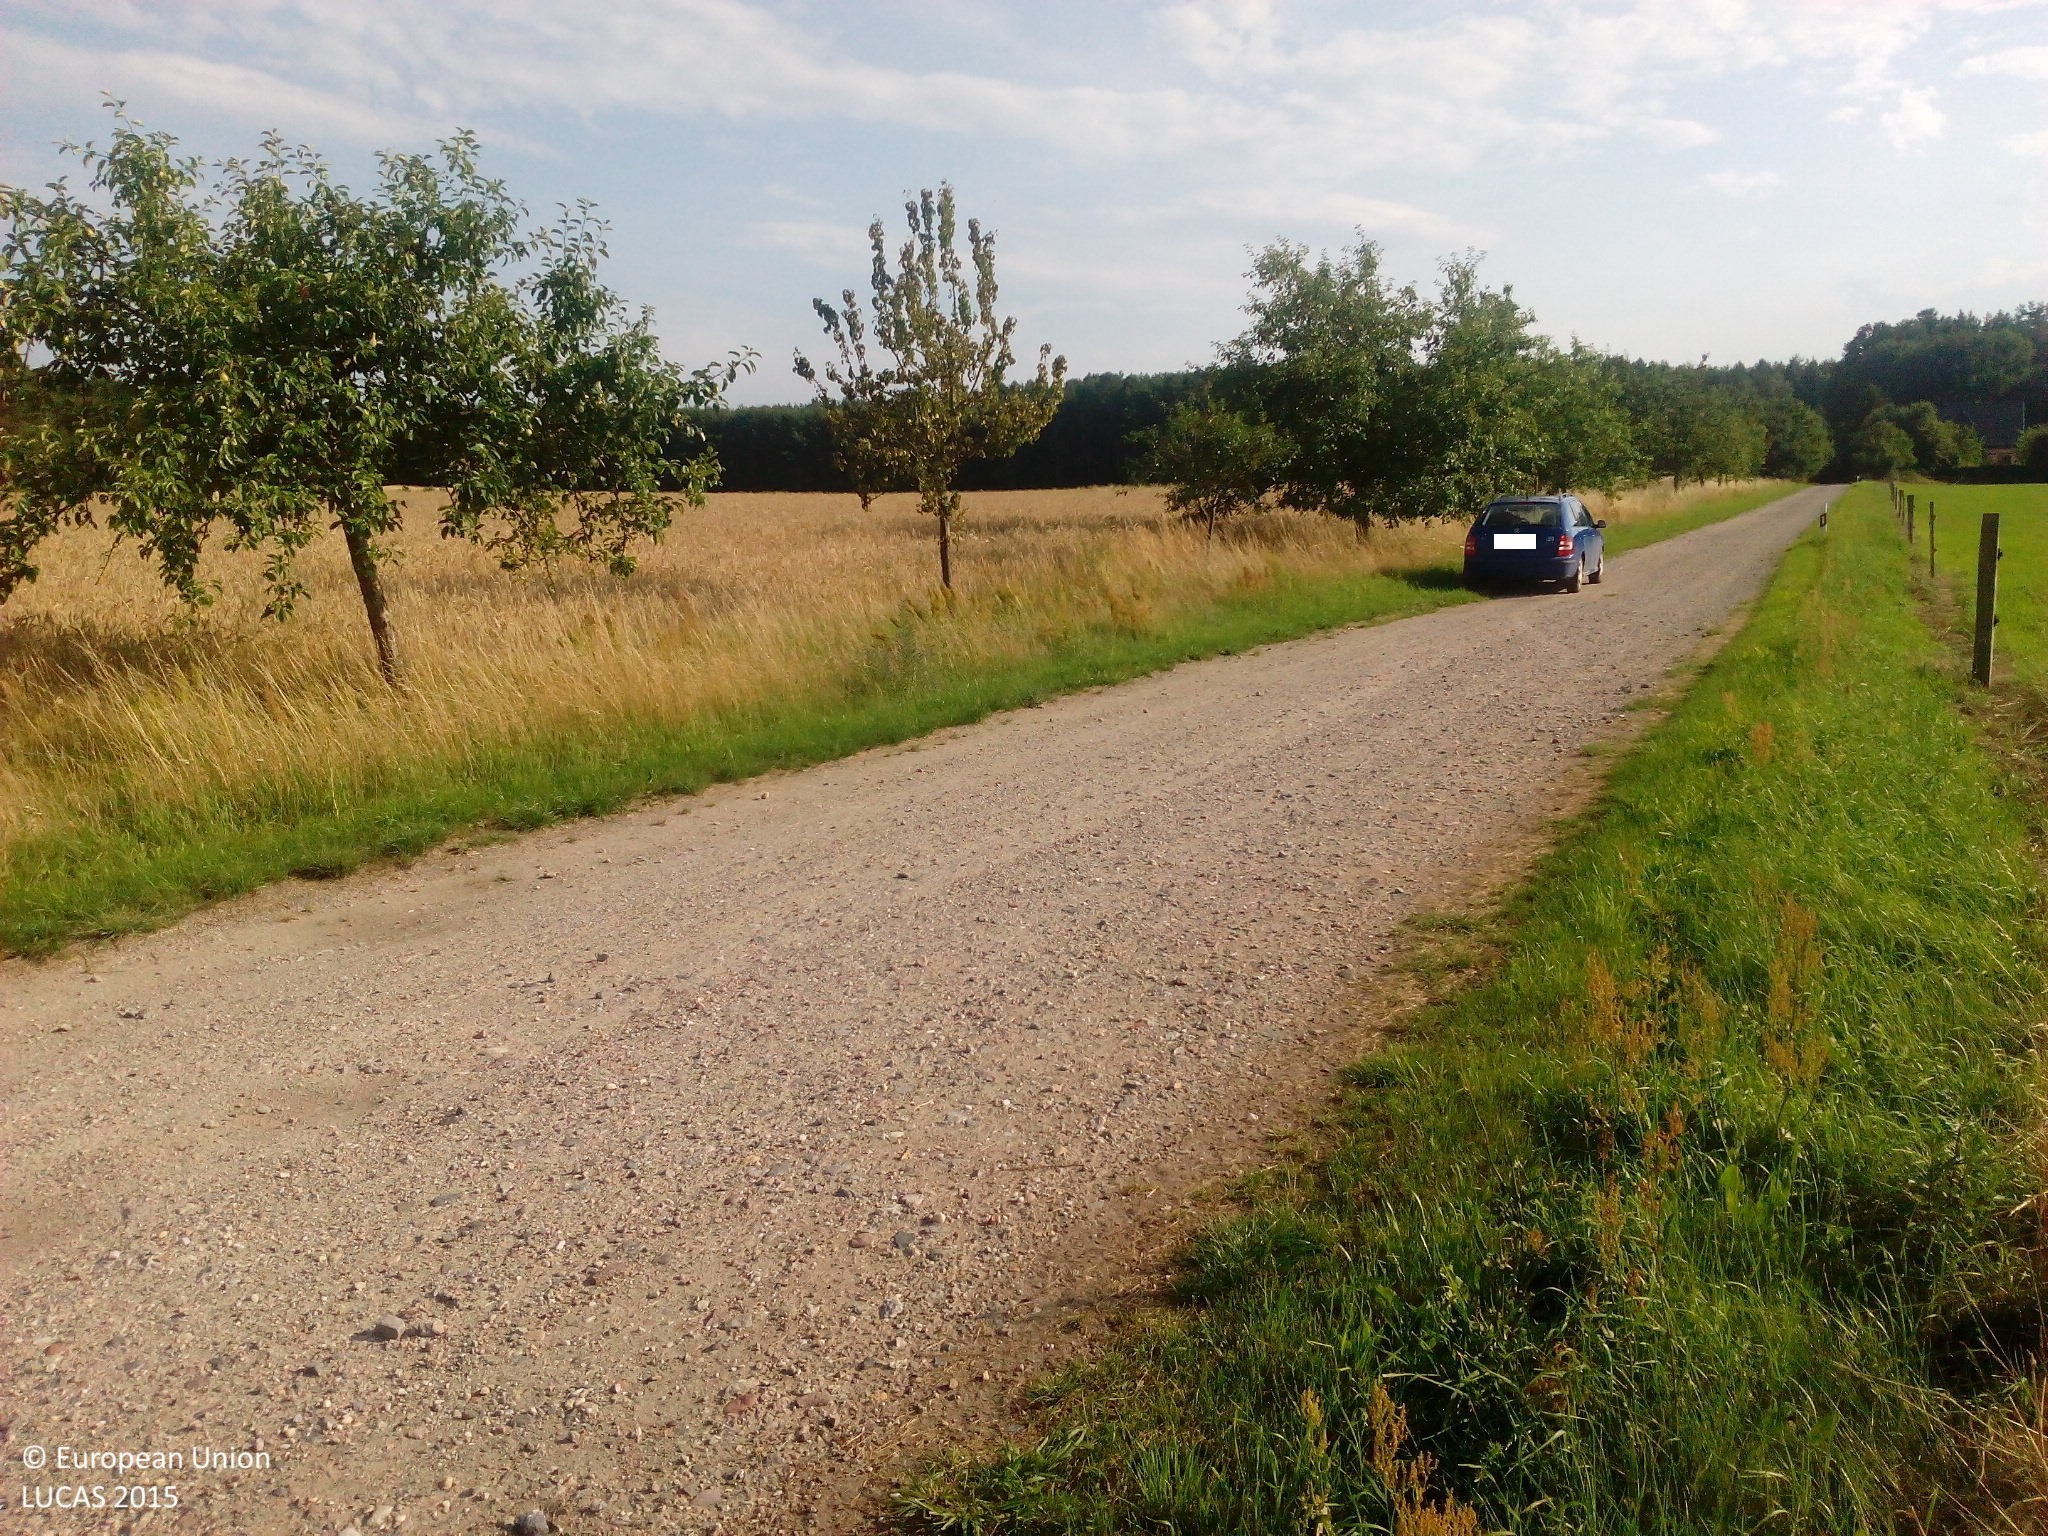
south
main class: Grassland
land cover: Grassland without tree/shrub cover
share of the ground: > 75 %
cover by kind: herbaceous plants 100 %
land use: Agriculture (excluding fallow land and kitchen gardens)
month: July
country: DE
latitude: 51.9898
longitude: 12.5773
